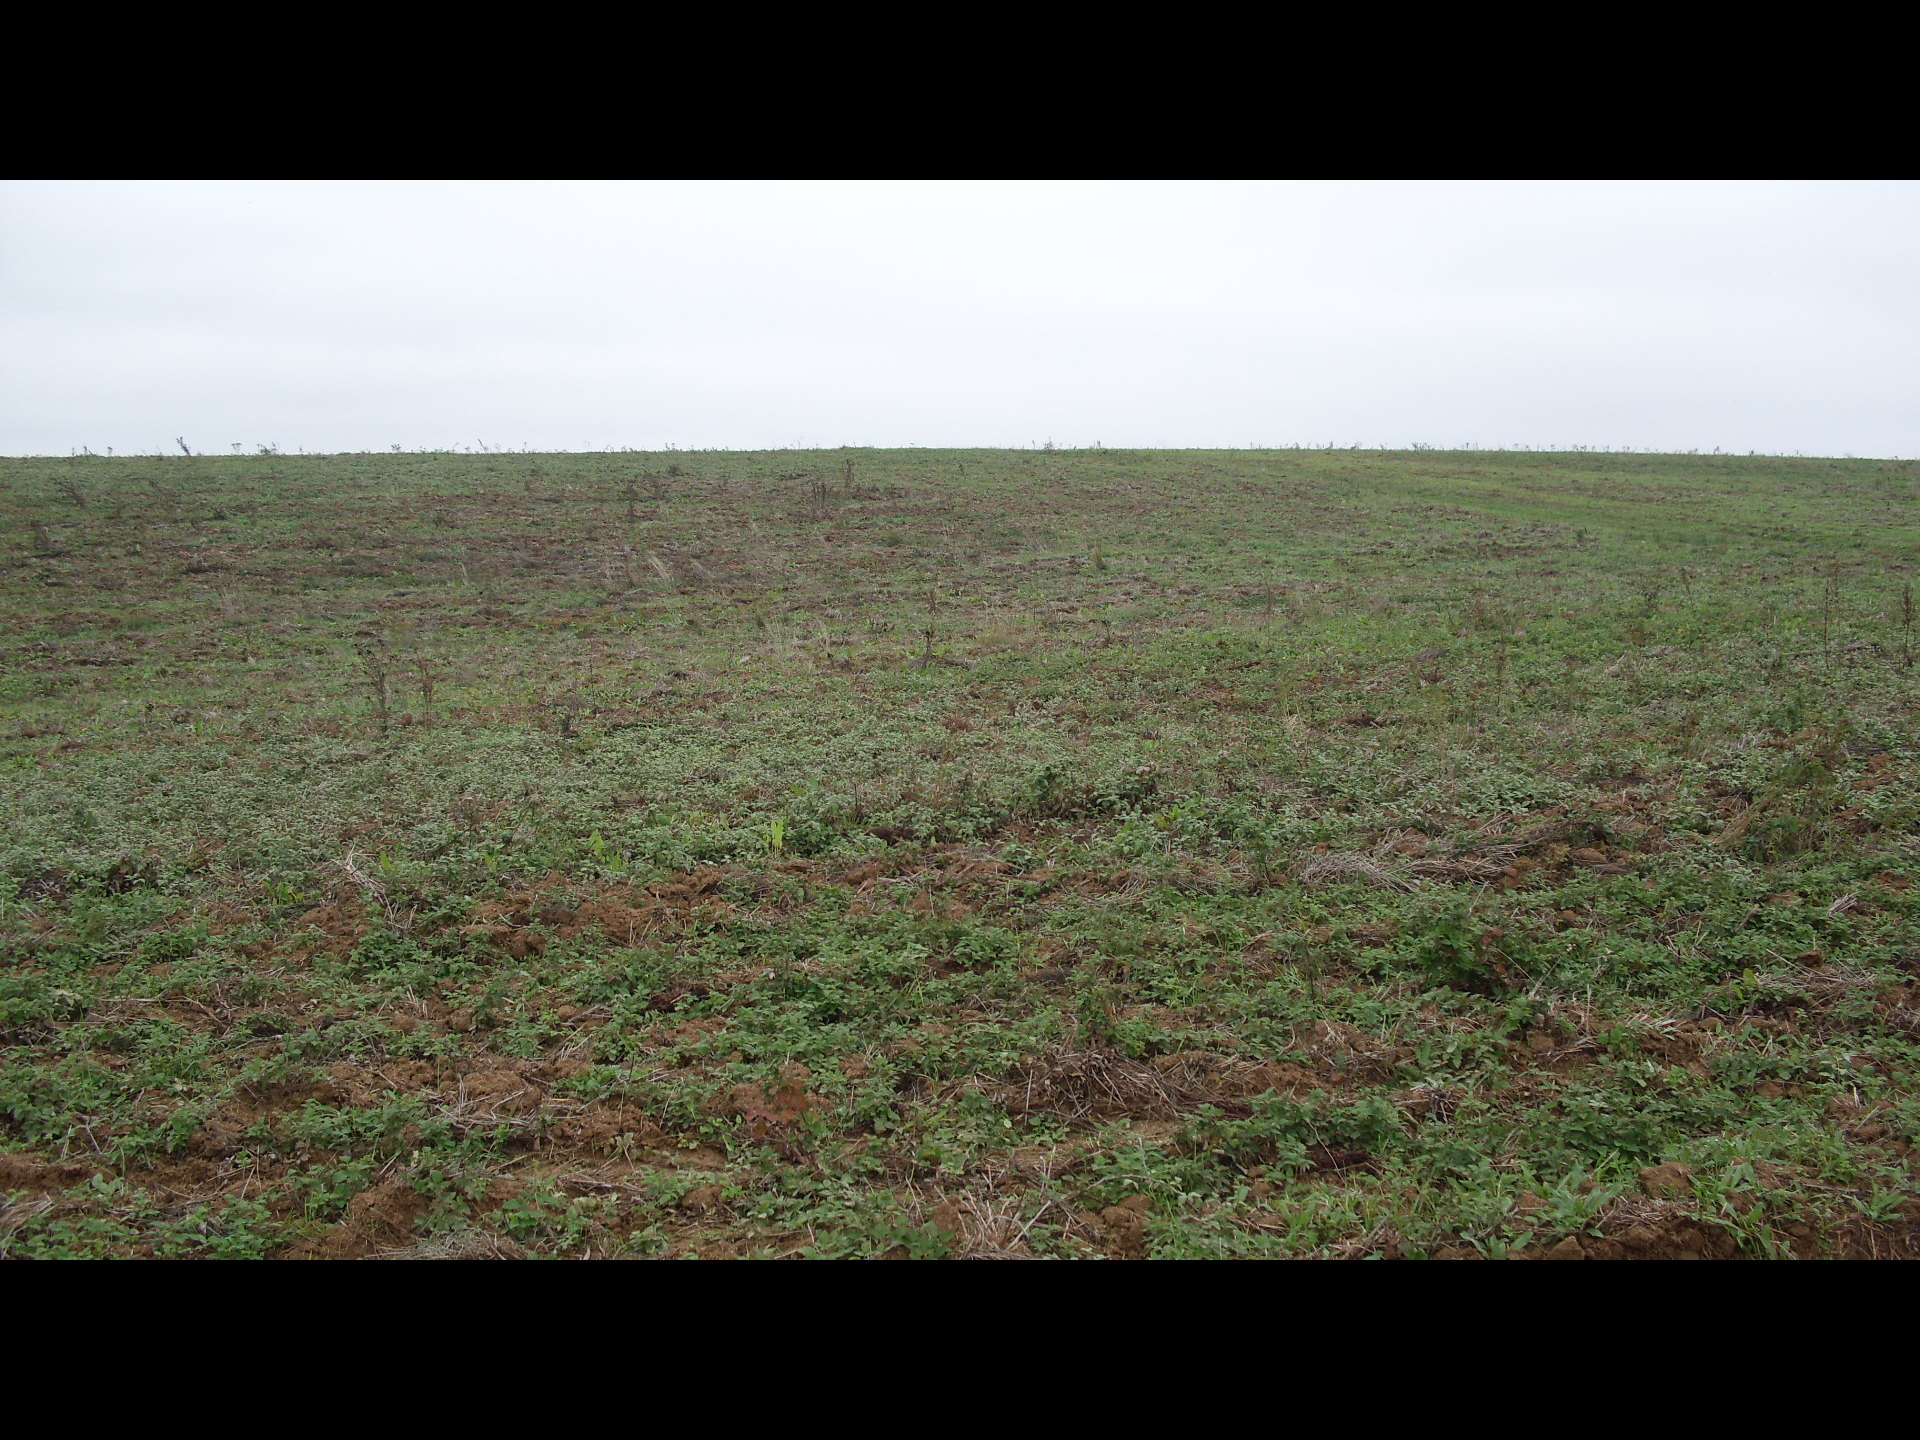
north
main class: Grassland
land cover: Spontaneously vegetated surfaces
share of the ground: 50 - 75 %
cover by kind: herbaceous plants 70 %, unconsolidated bare surface 30 %
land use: Agriculture (excluding fallow land and kitchen gardens)
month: October
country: BG
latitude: 43.6824
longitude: 22.6497
